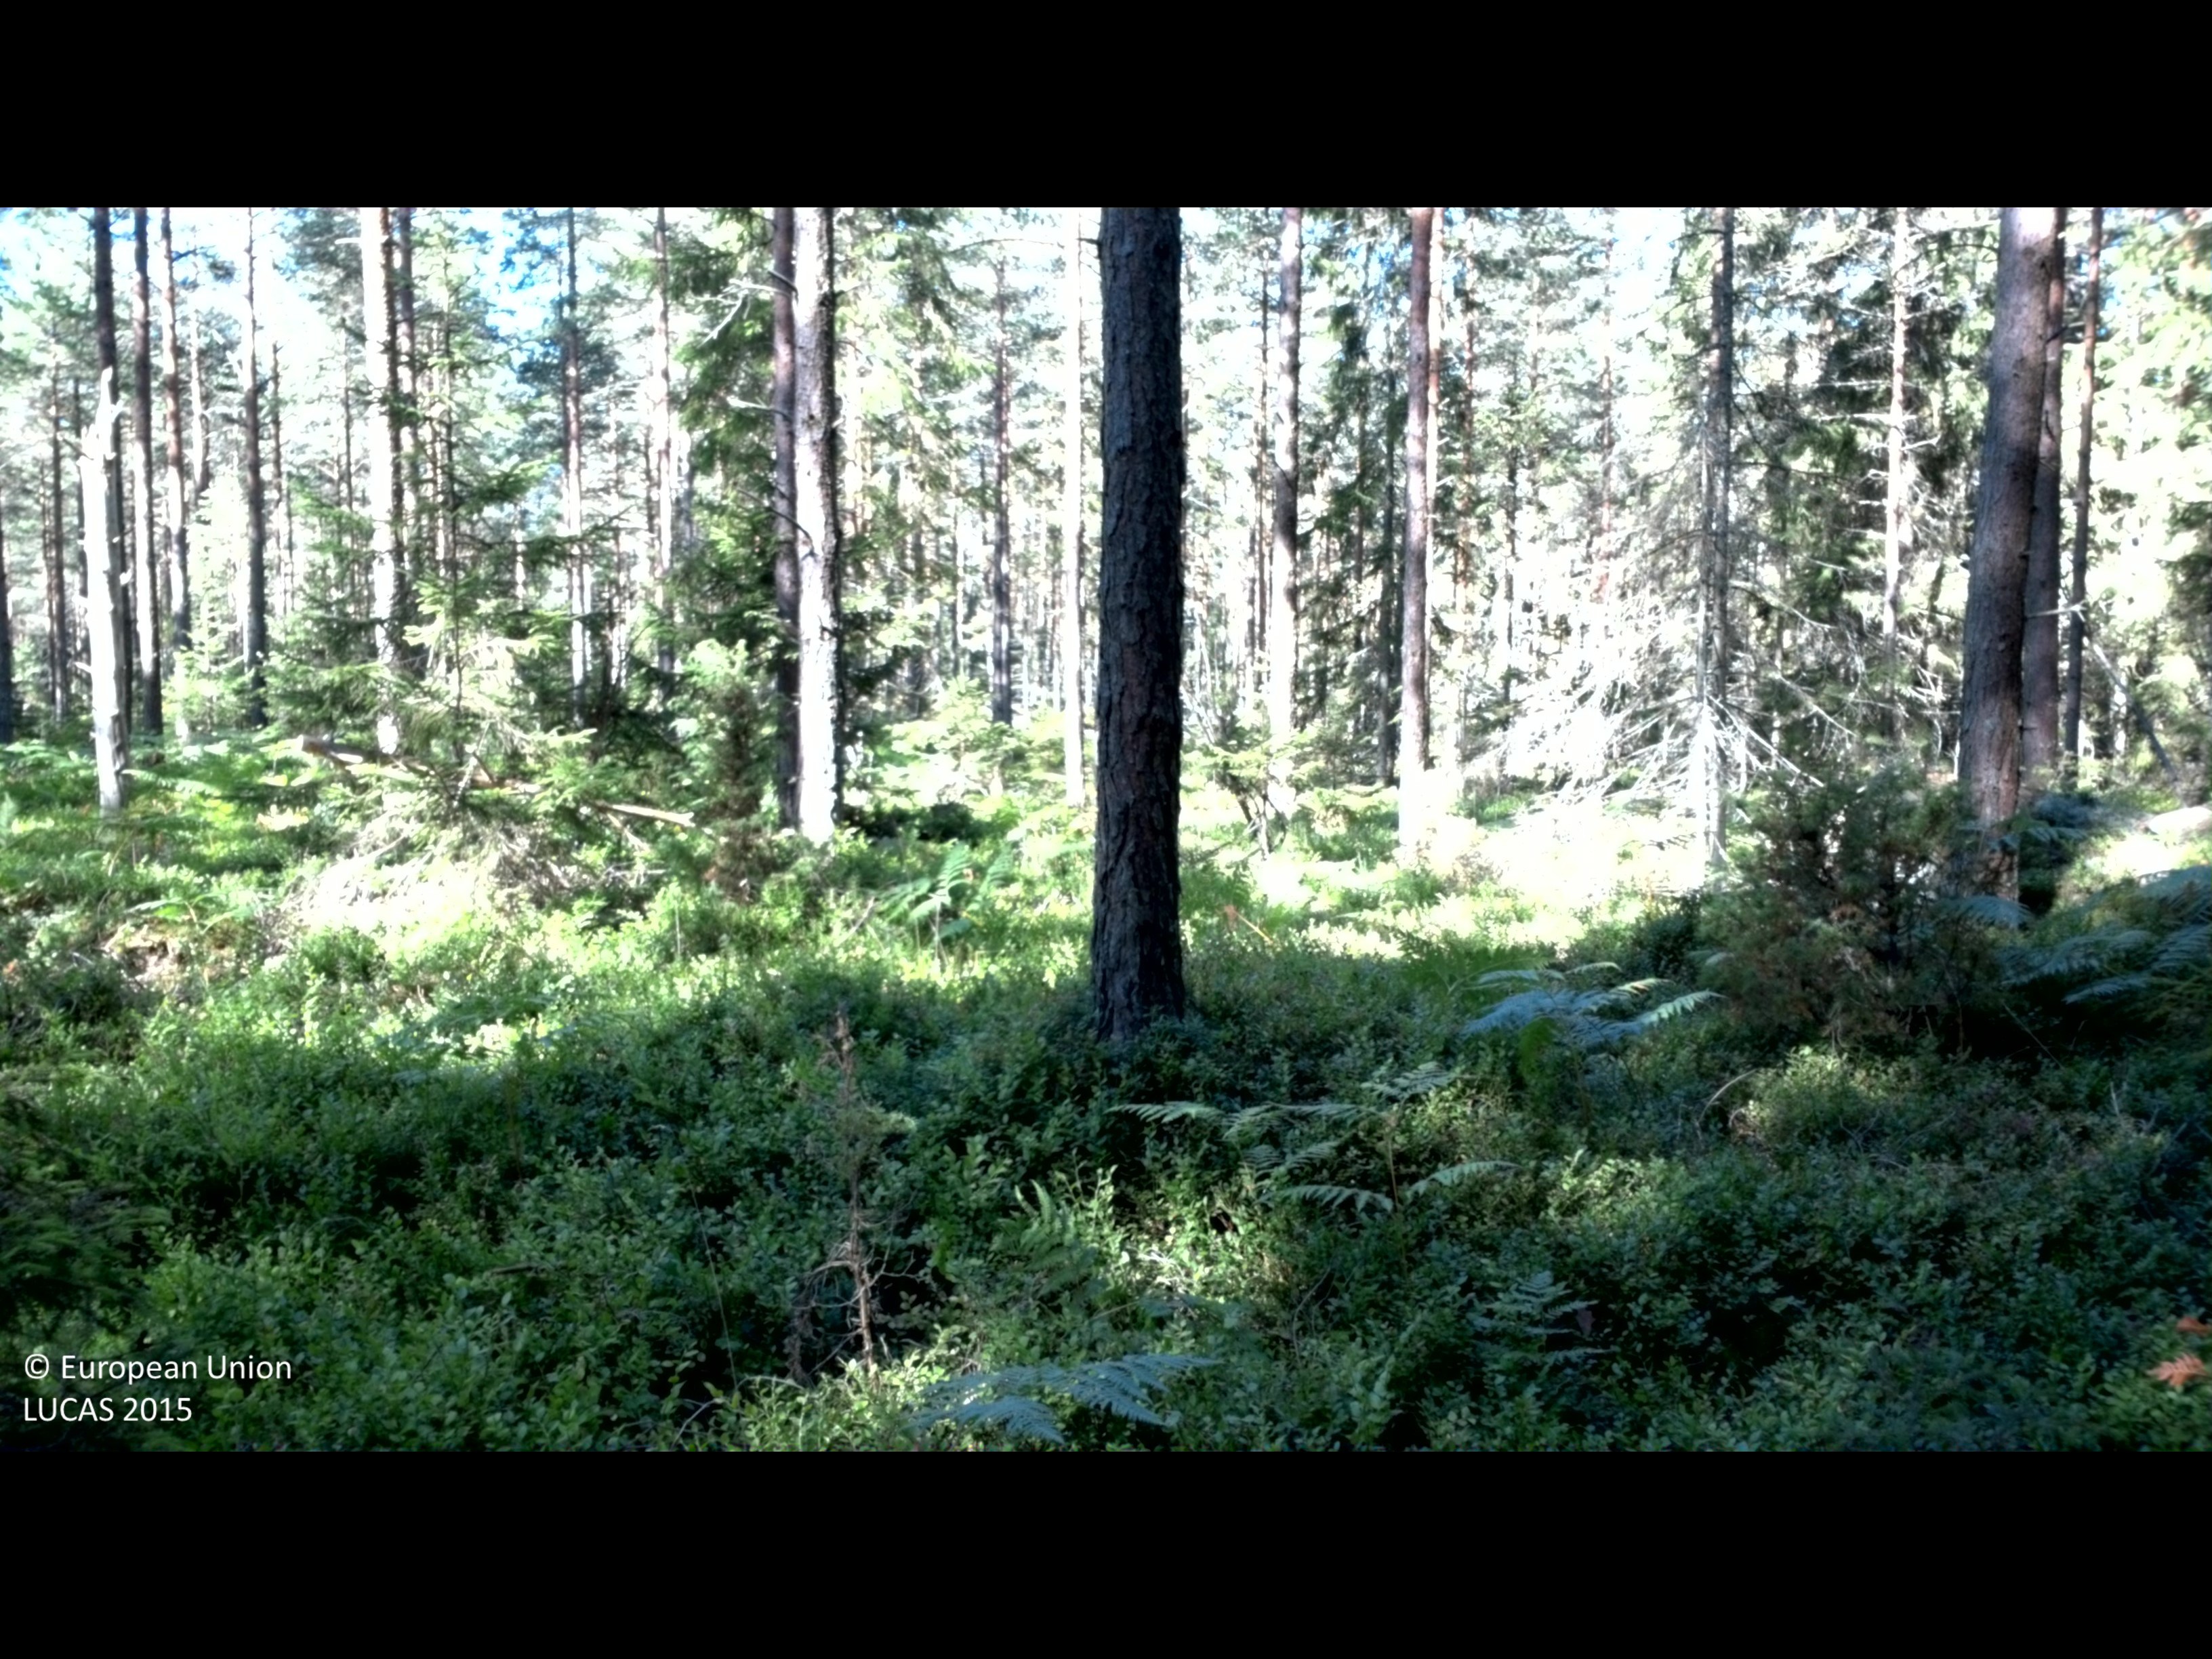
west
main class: Woodland
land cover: Pine dominated coniferous woodland
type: boreal forest
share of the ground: 50 - 75 %
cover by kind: coniferous forest trees 55 %, shrubs 45 %
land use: Forestry
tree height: > 5 m
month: August
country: SE
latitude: 56.3501
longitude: 14.8040
